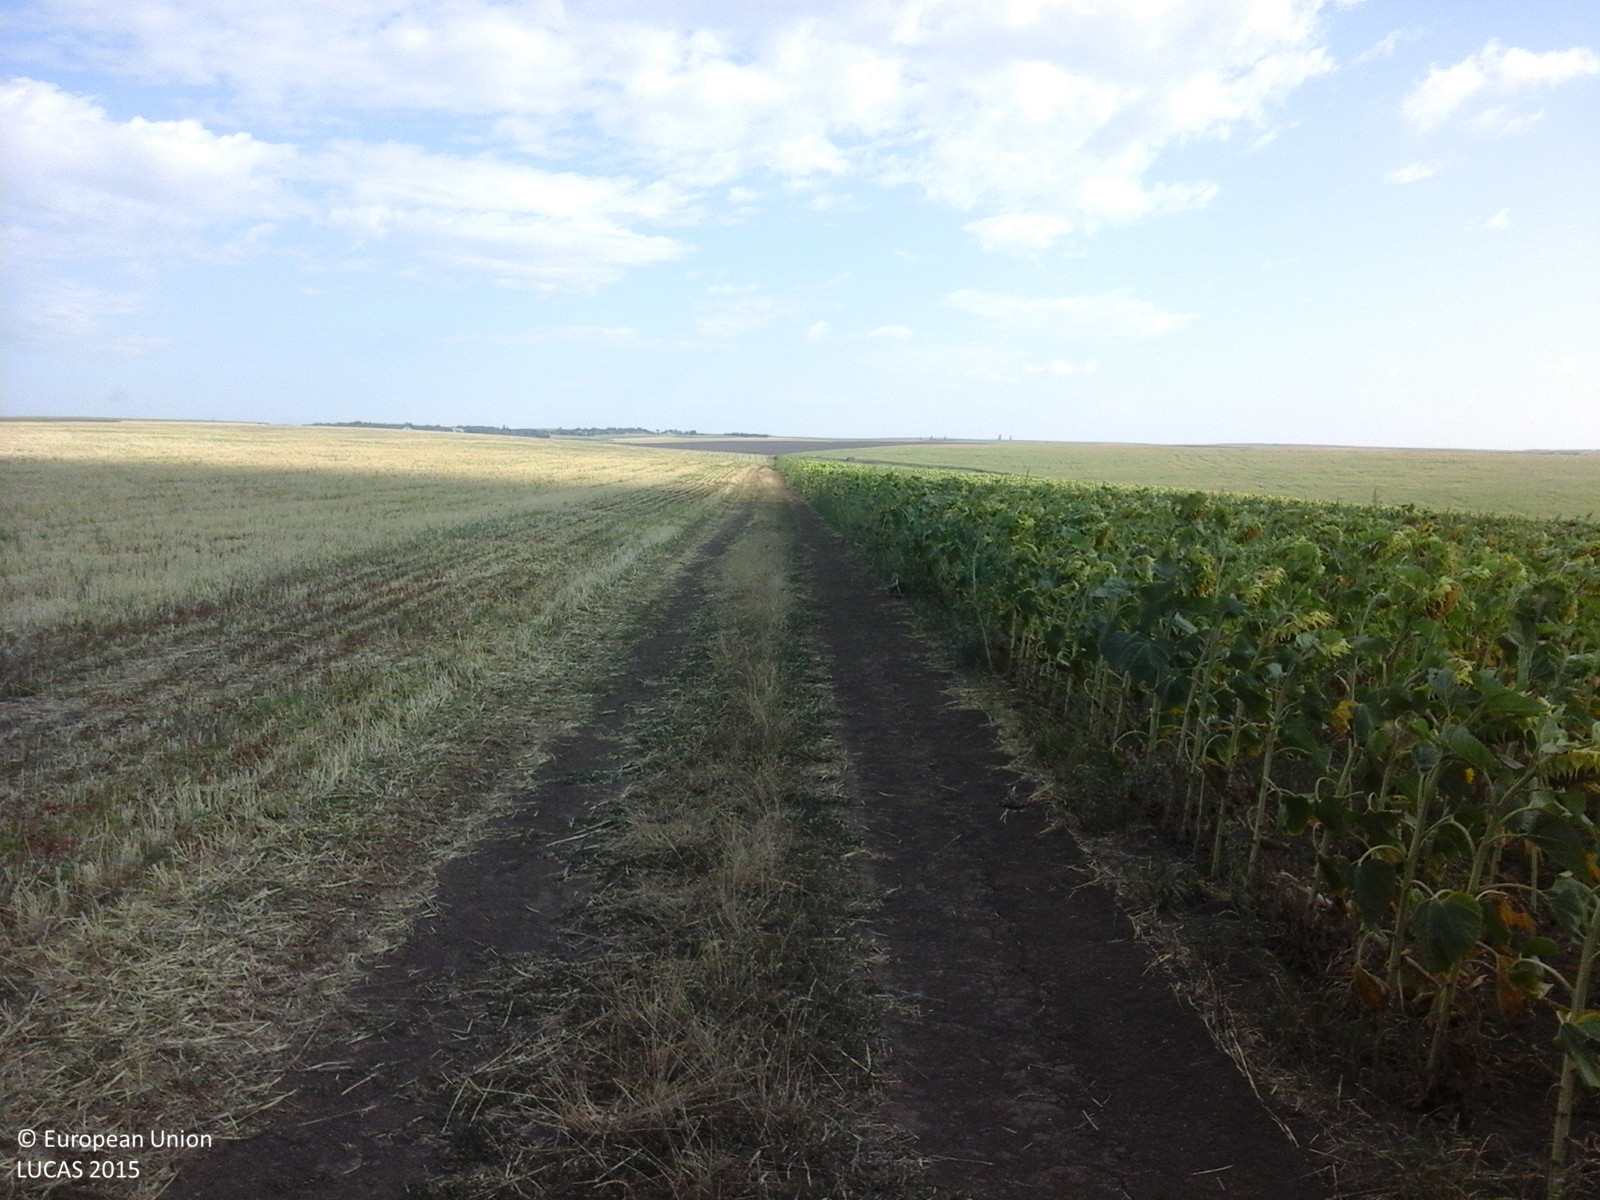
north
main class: Cropland
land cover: Sunflower
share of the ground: > 75 %
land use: Agriculture (excluding fallow land and kitchen gardens)
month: July
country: RO
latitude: 46.1350
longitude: 27.7850
